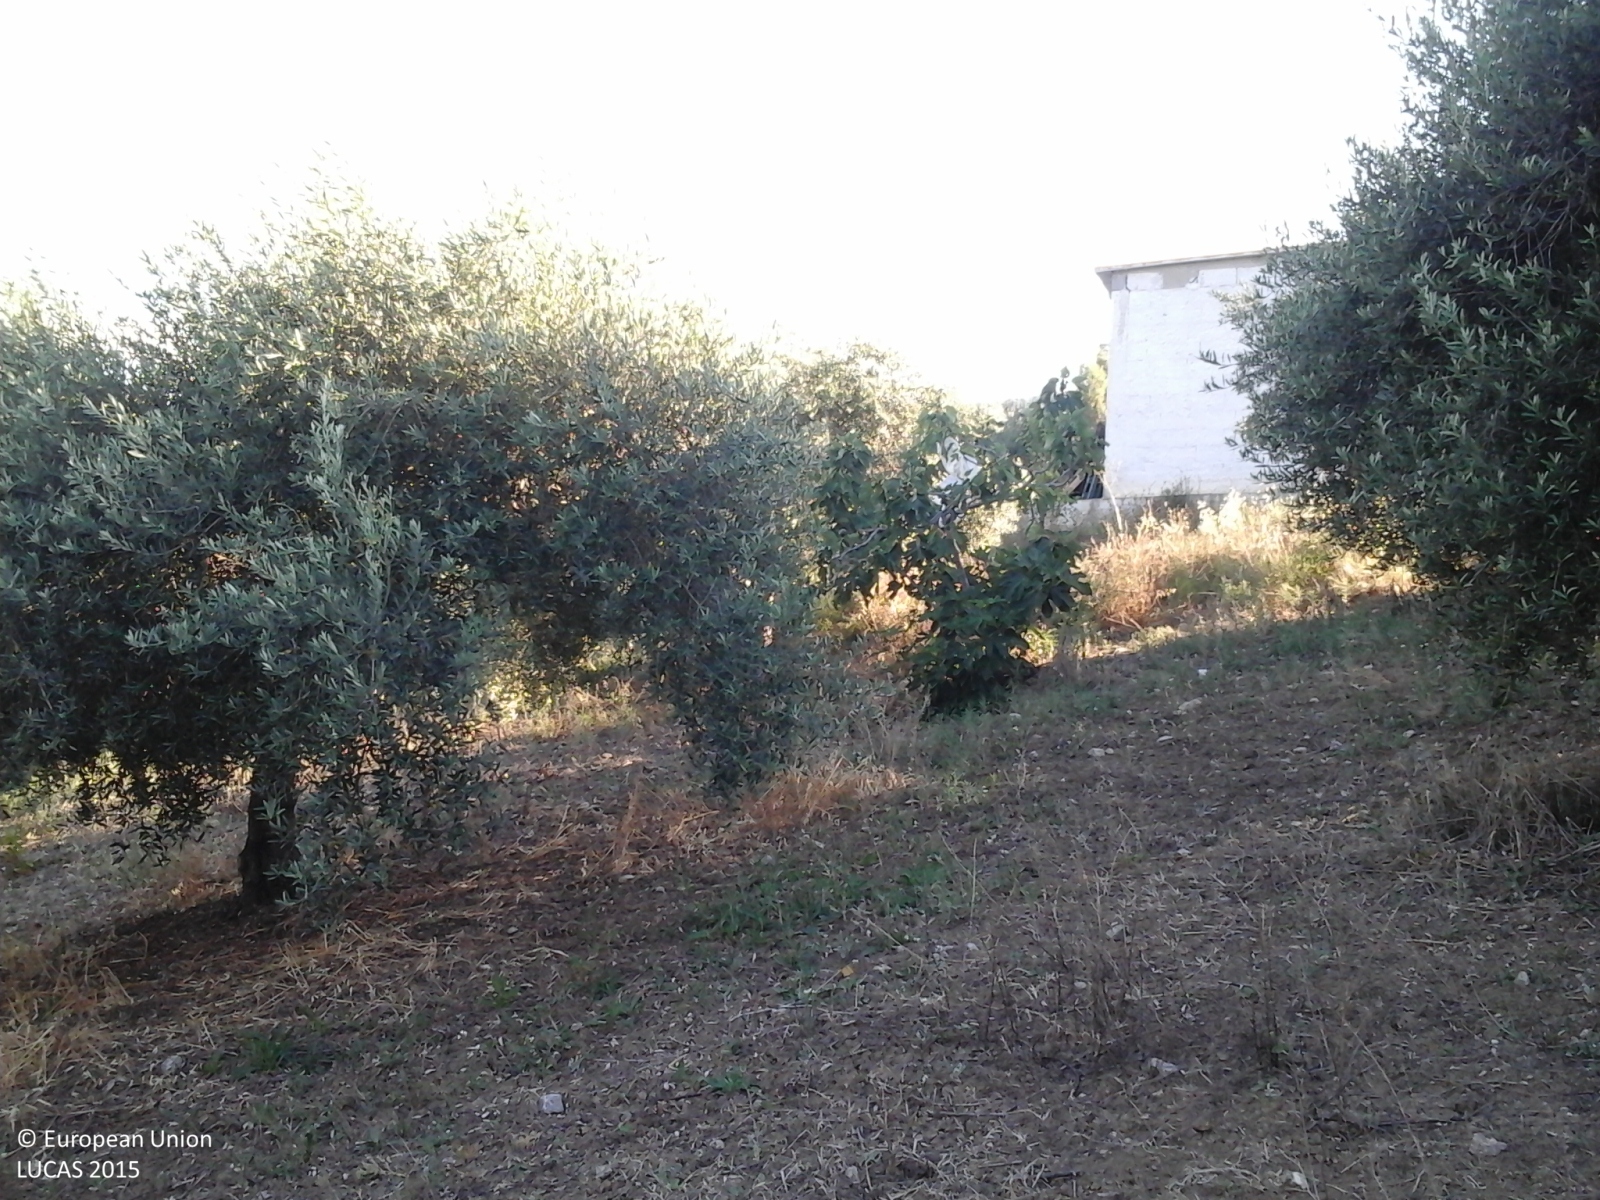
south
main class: Cropland
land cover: Olive groves
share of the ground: 50 - 75 %
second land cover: Spontaneously vegetated surfaces
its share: > 75 %
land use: Agriculture (excluding fallow land and kitchen gardens)
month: June
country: IT
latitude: 38.0276
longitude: 13.5182
